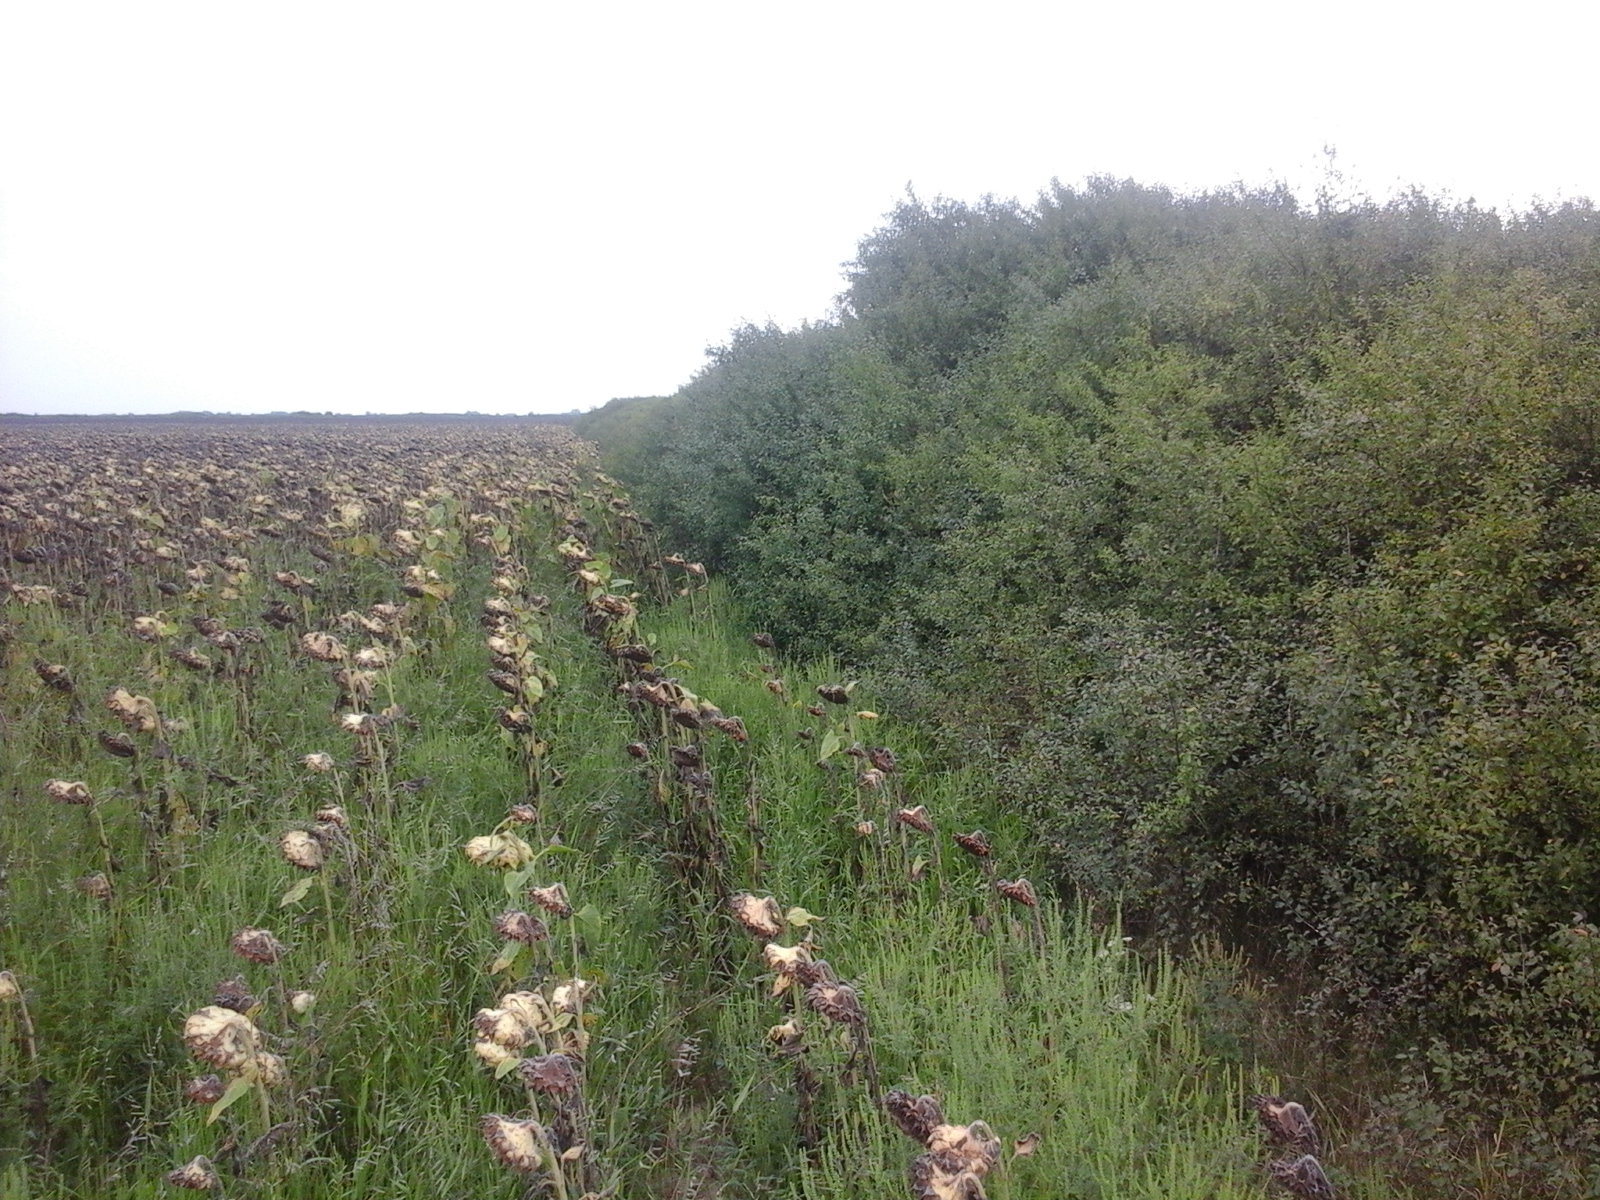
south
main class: Cropland
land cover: Sunflower
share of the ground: > 75 %
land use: Agriculture (excluding fallow land and kitchen gardens)
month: August
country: RO
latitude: 46.7047
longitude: 21.7216
